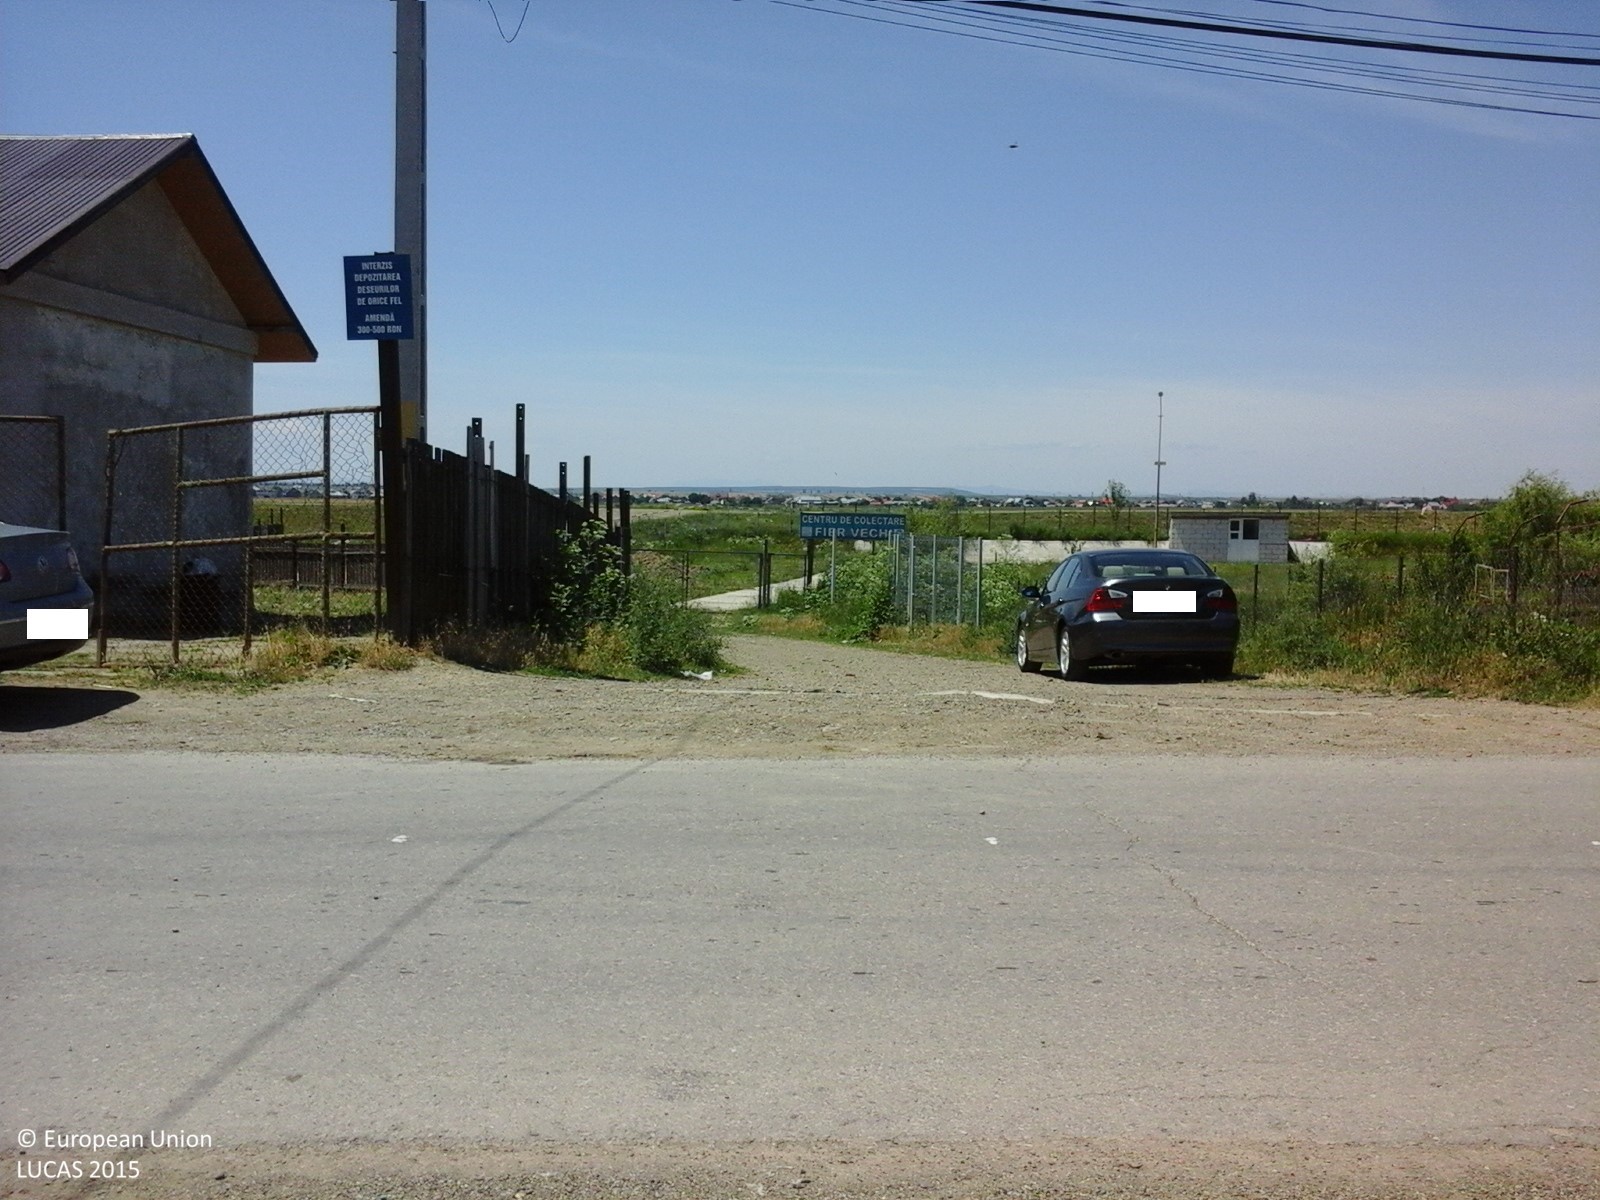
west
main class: Grassland
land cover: Grassland without tree/shrub cover
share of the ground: > 75 %
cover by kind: herbaceous plants 100 %
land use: Residential
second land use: Agriculture (excluding fallow land and kitchen gardens)
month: June
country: RO
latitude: 47.0047
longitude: 26.9733
